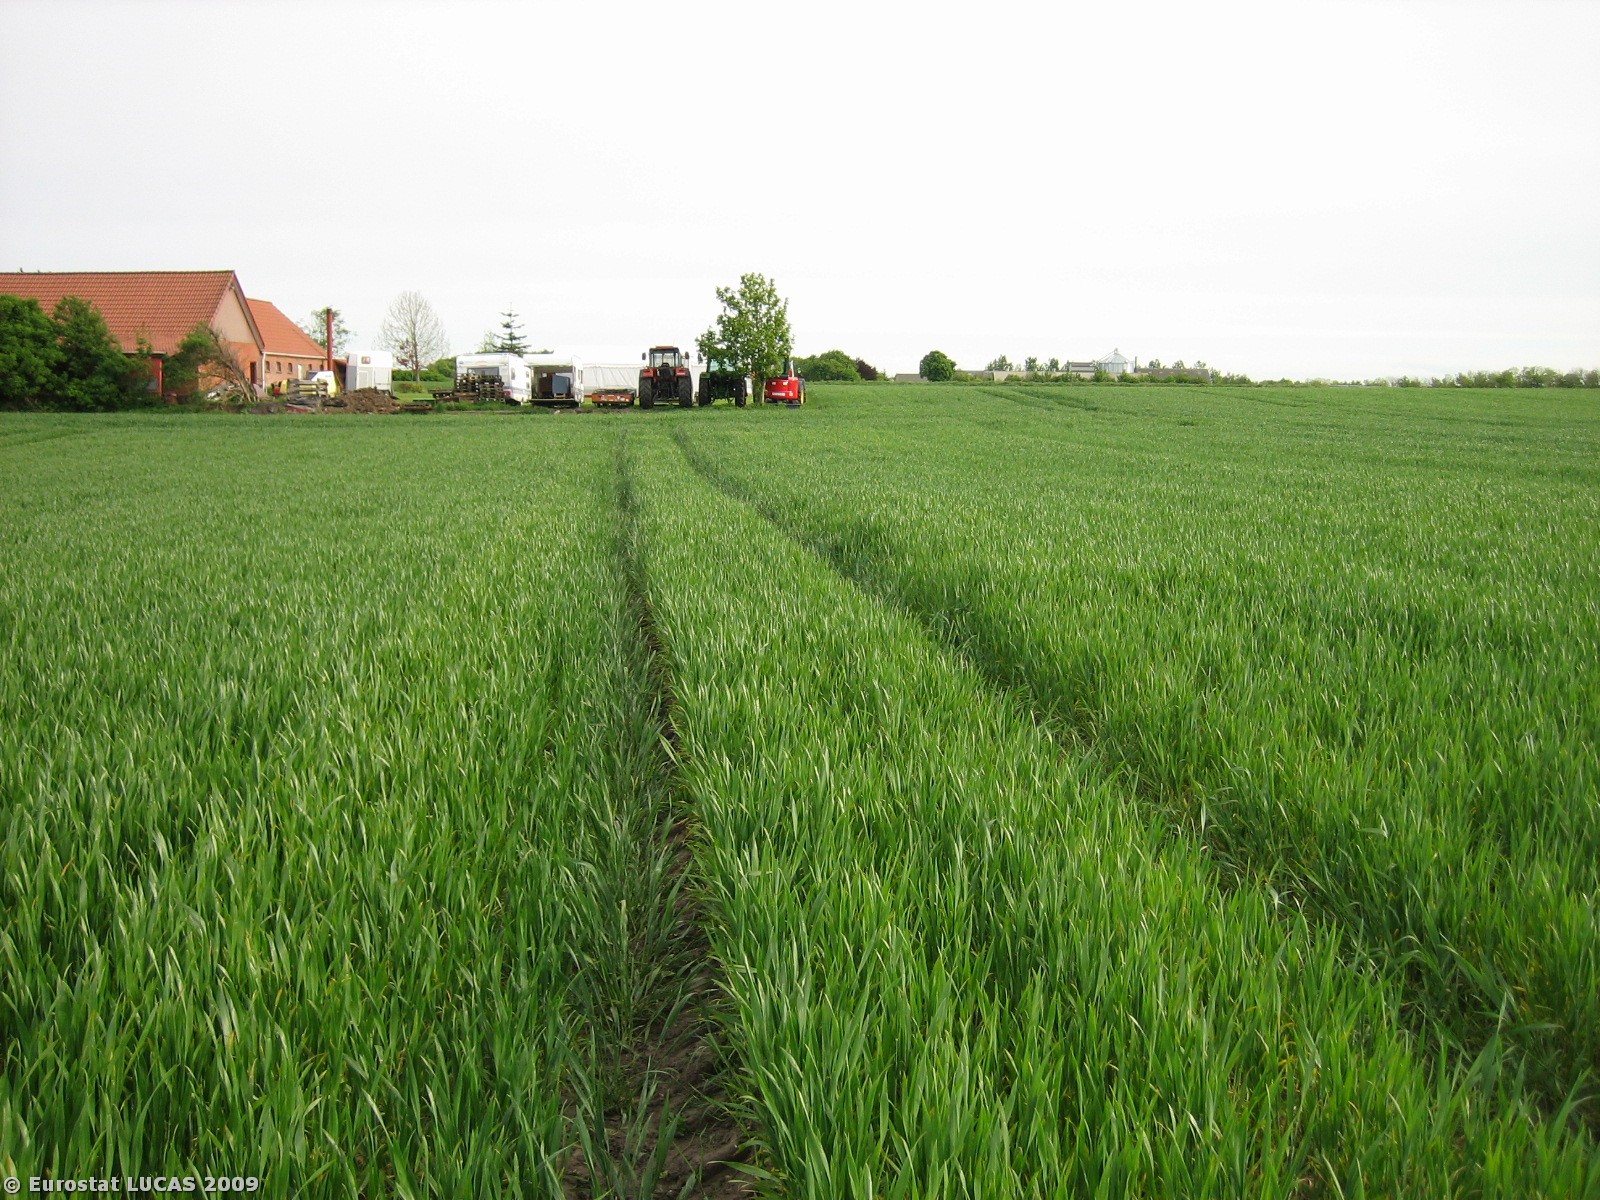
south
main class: Cropland
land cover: Common wheat
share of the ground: > 75 %
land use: Agriculture (excluding fallow land and kitchen gardens)
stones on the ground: < 10 %
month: May
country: DK
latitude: 56.1247
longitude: 8.4734
